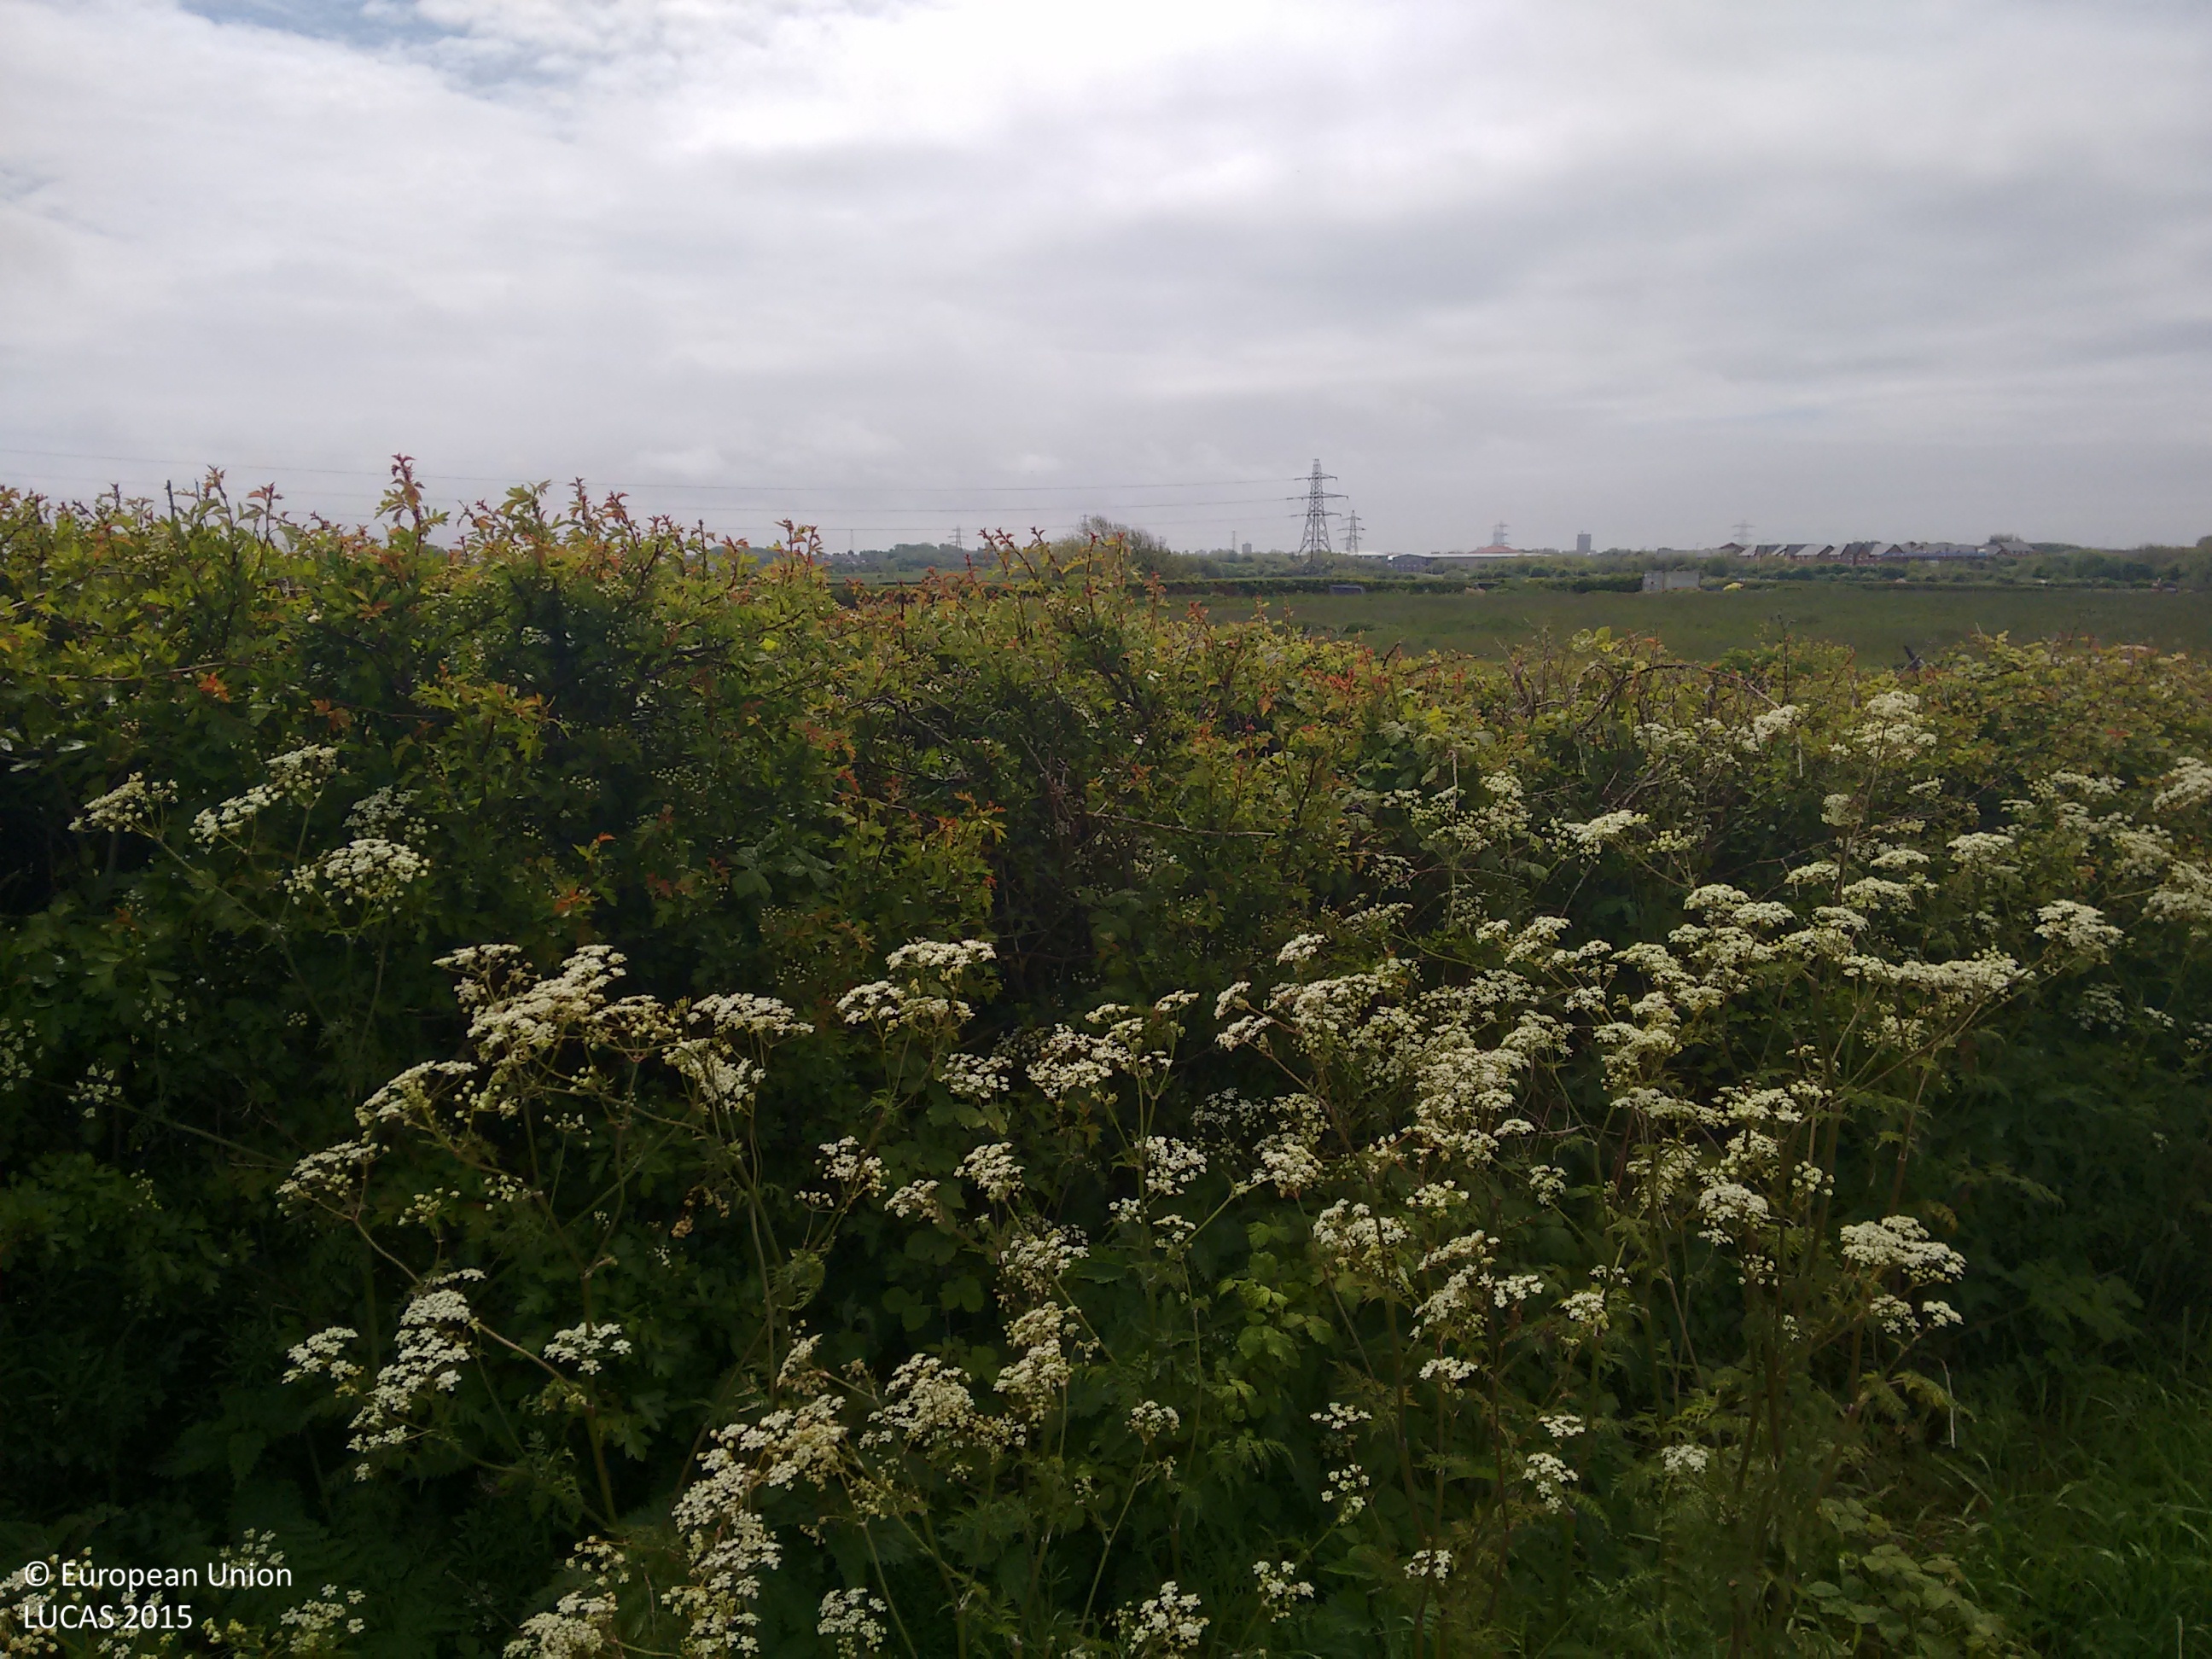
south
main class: Grassland
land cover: Grassland without tree/shrub cover
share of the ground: > 75 %
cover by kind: herbaceous plants 100 %
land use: Agriculture (excluding fallow land and kitchen gardens)
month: May
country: GB
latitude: 53.8622
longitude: -3.0137
